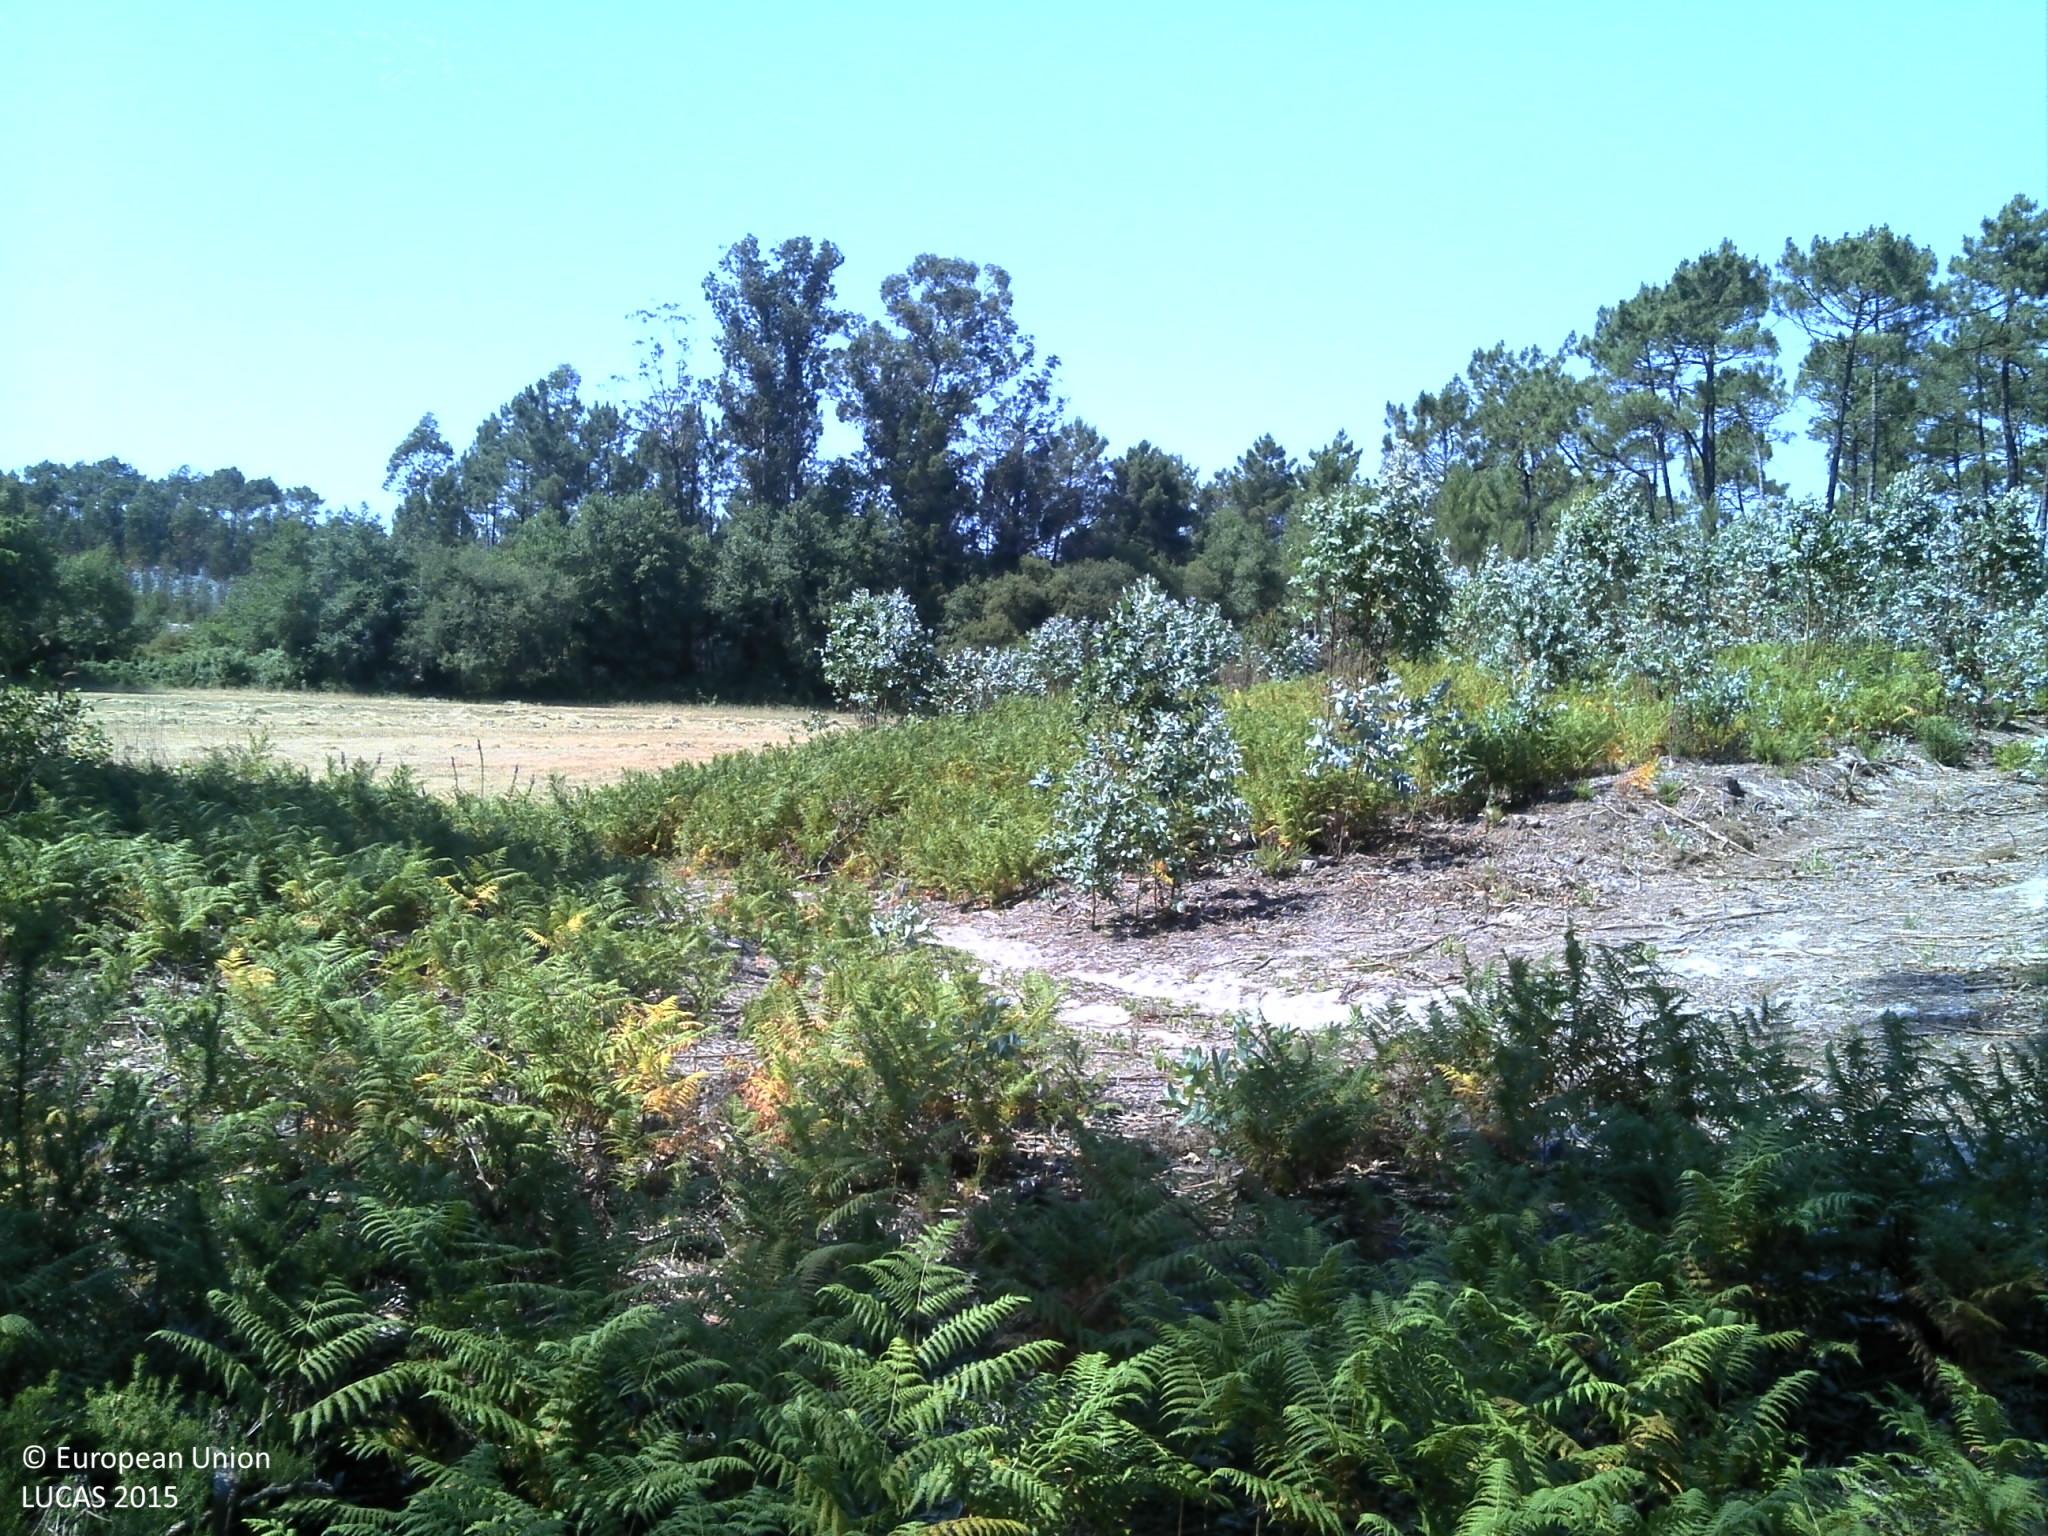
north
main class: Woodland
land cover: Broadleaved woodland
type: exotic forest
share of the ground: 25 - 50 %
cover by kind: broadleaved forest trees 45 %, shrubs 30 %, unconsolidated bare surface 25 %
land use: Forestry
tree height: > 5 m
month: June
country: PT
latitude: 40.3250
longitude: -8.6764
